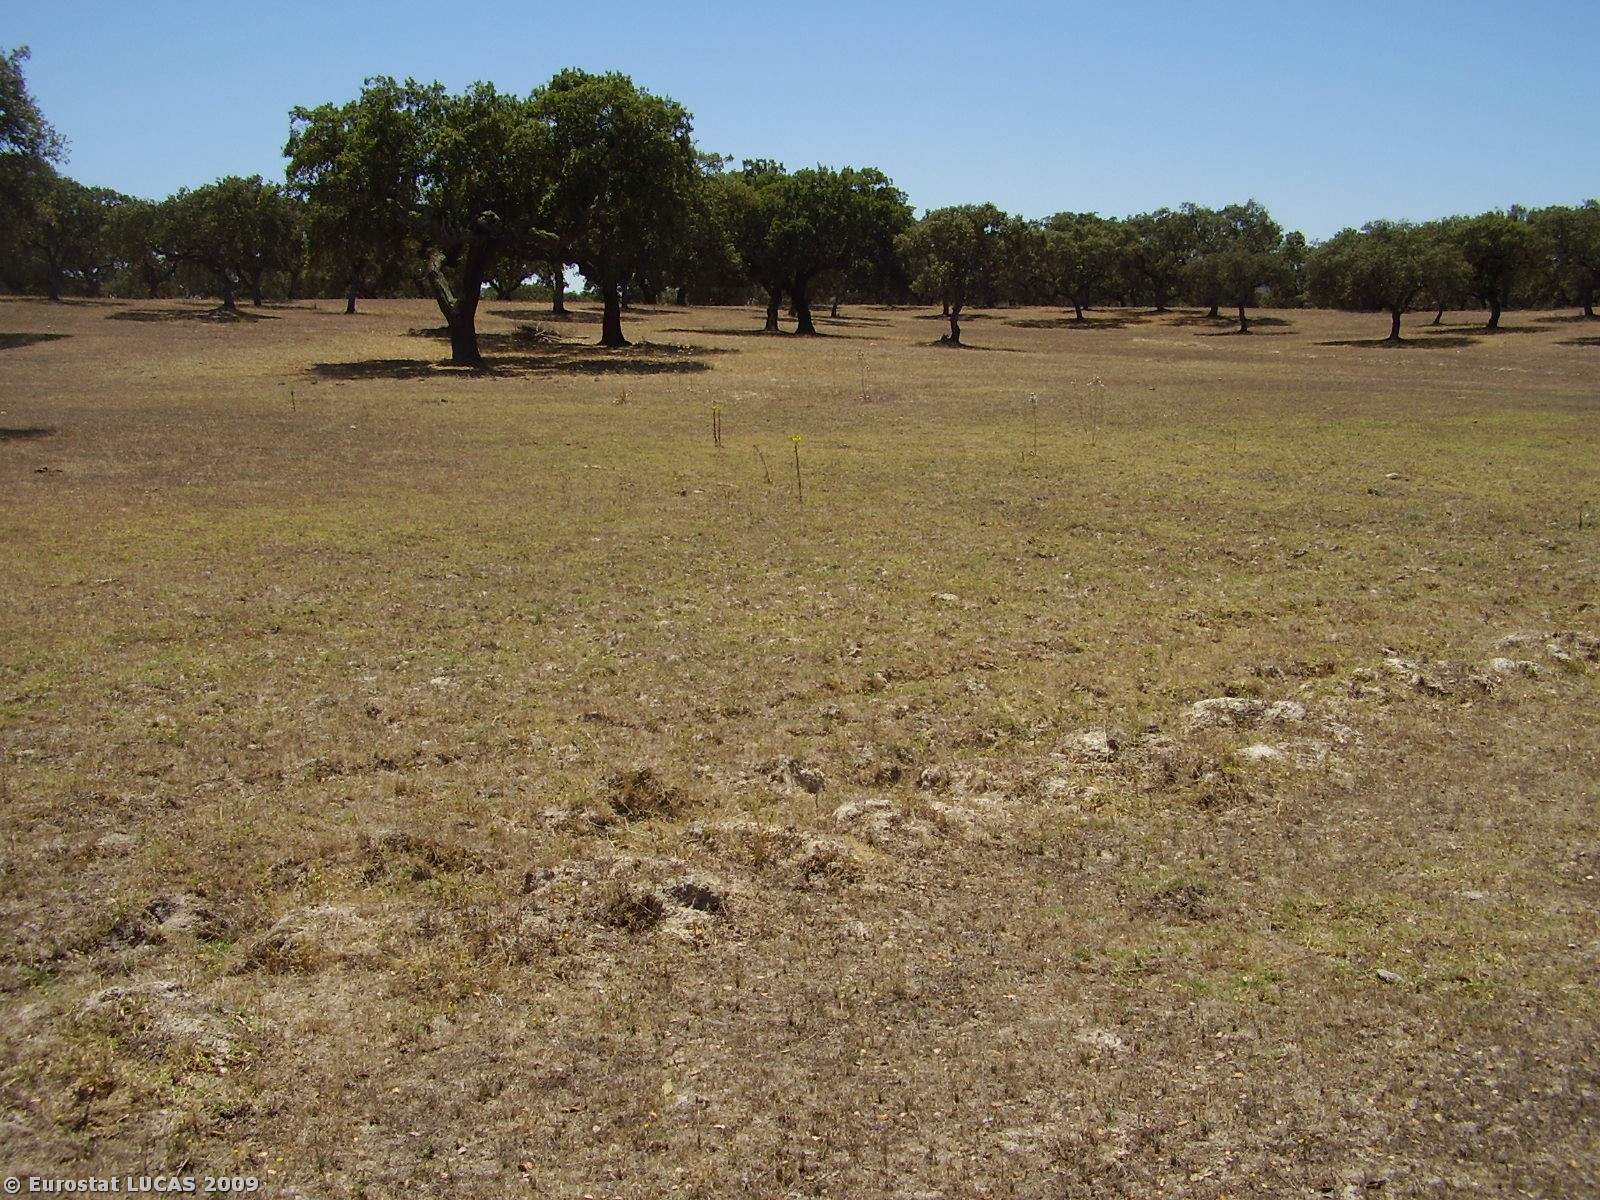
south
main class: Woodland
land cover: Broadleaved woodland
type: broadleaved evergreen forest
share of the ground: 10 - 25 %
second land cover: Grassland with sparse tree/shrub cover
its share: 50 - 75 %
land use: Forestry
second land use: Fallow land
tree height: > 5 m
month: July
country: PT
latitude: 38.8392
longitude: -7.9369
